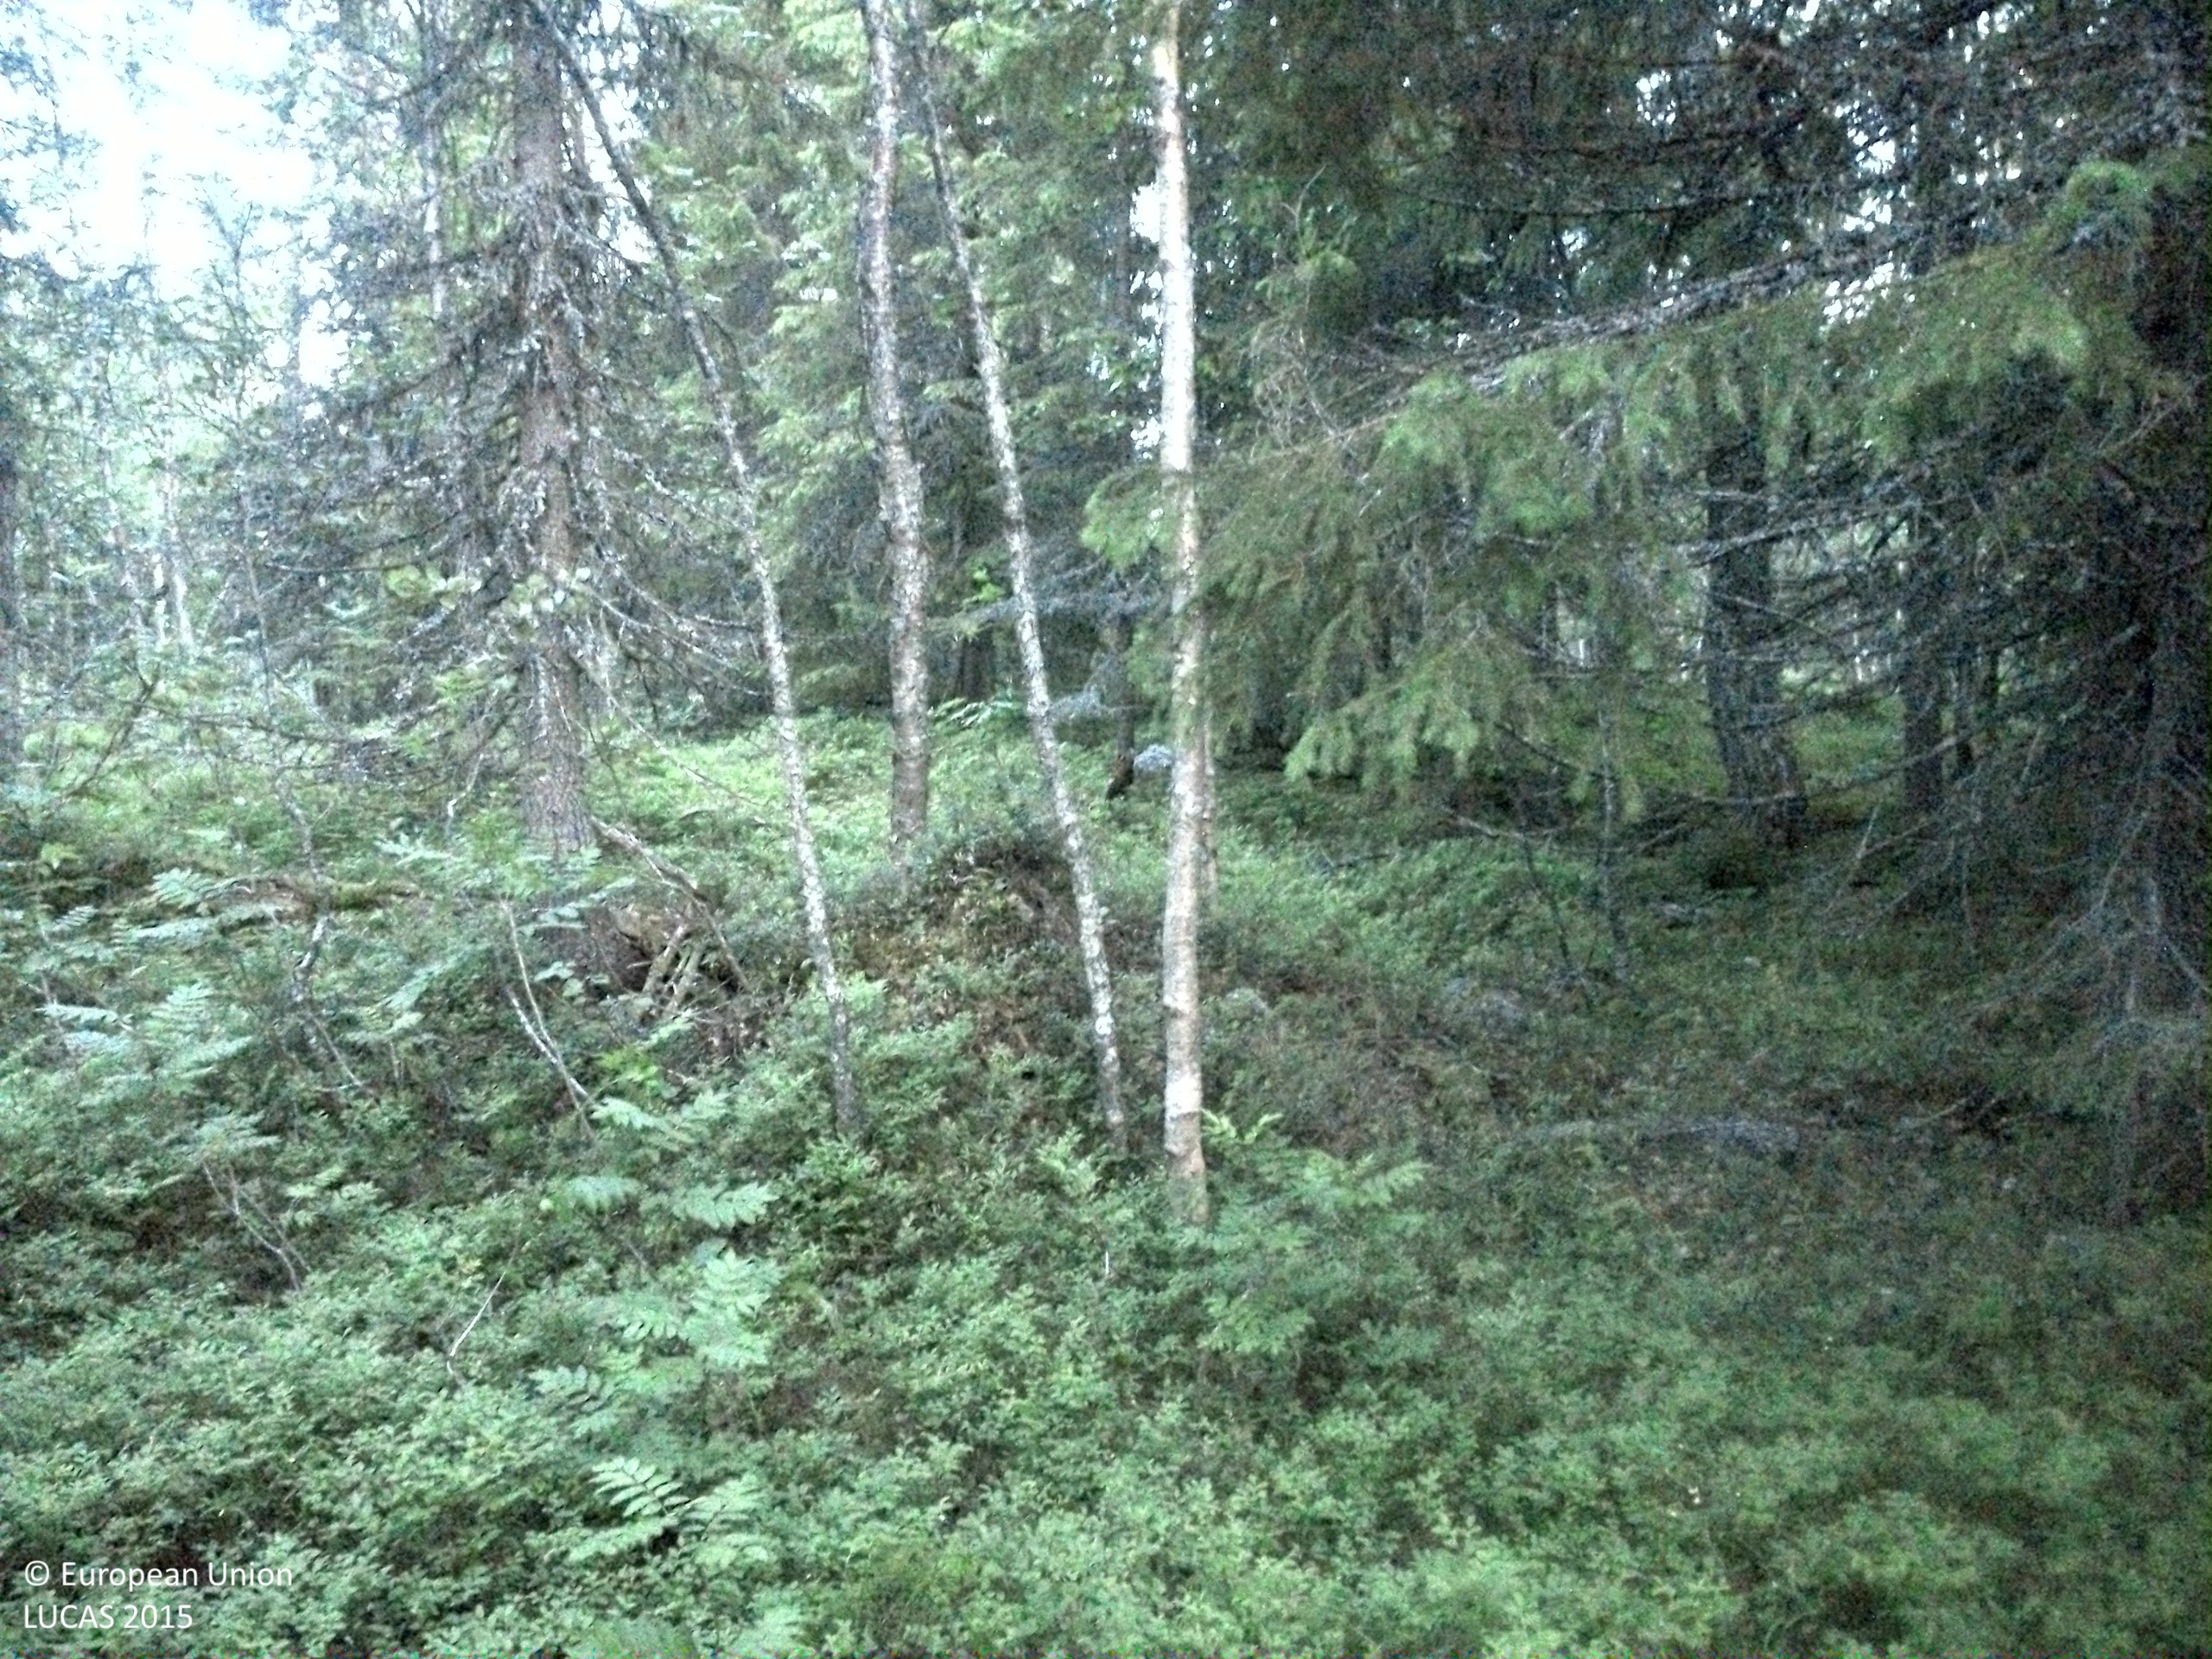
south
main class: Woodland
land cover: Spruce dominated mixed woodland
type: boreal forest
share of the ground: 50 - 75 %
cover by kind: coniferous forest trees 45 %, broadleaved forest trees 25 %, shrubs 20 %, herbaceous plants 5 %, lichens and mosses 5 %
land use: Forestry
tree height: > 5 m
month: July
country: SE
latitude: 64.6045
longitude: 15.6743
